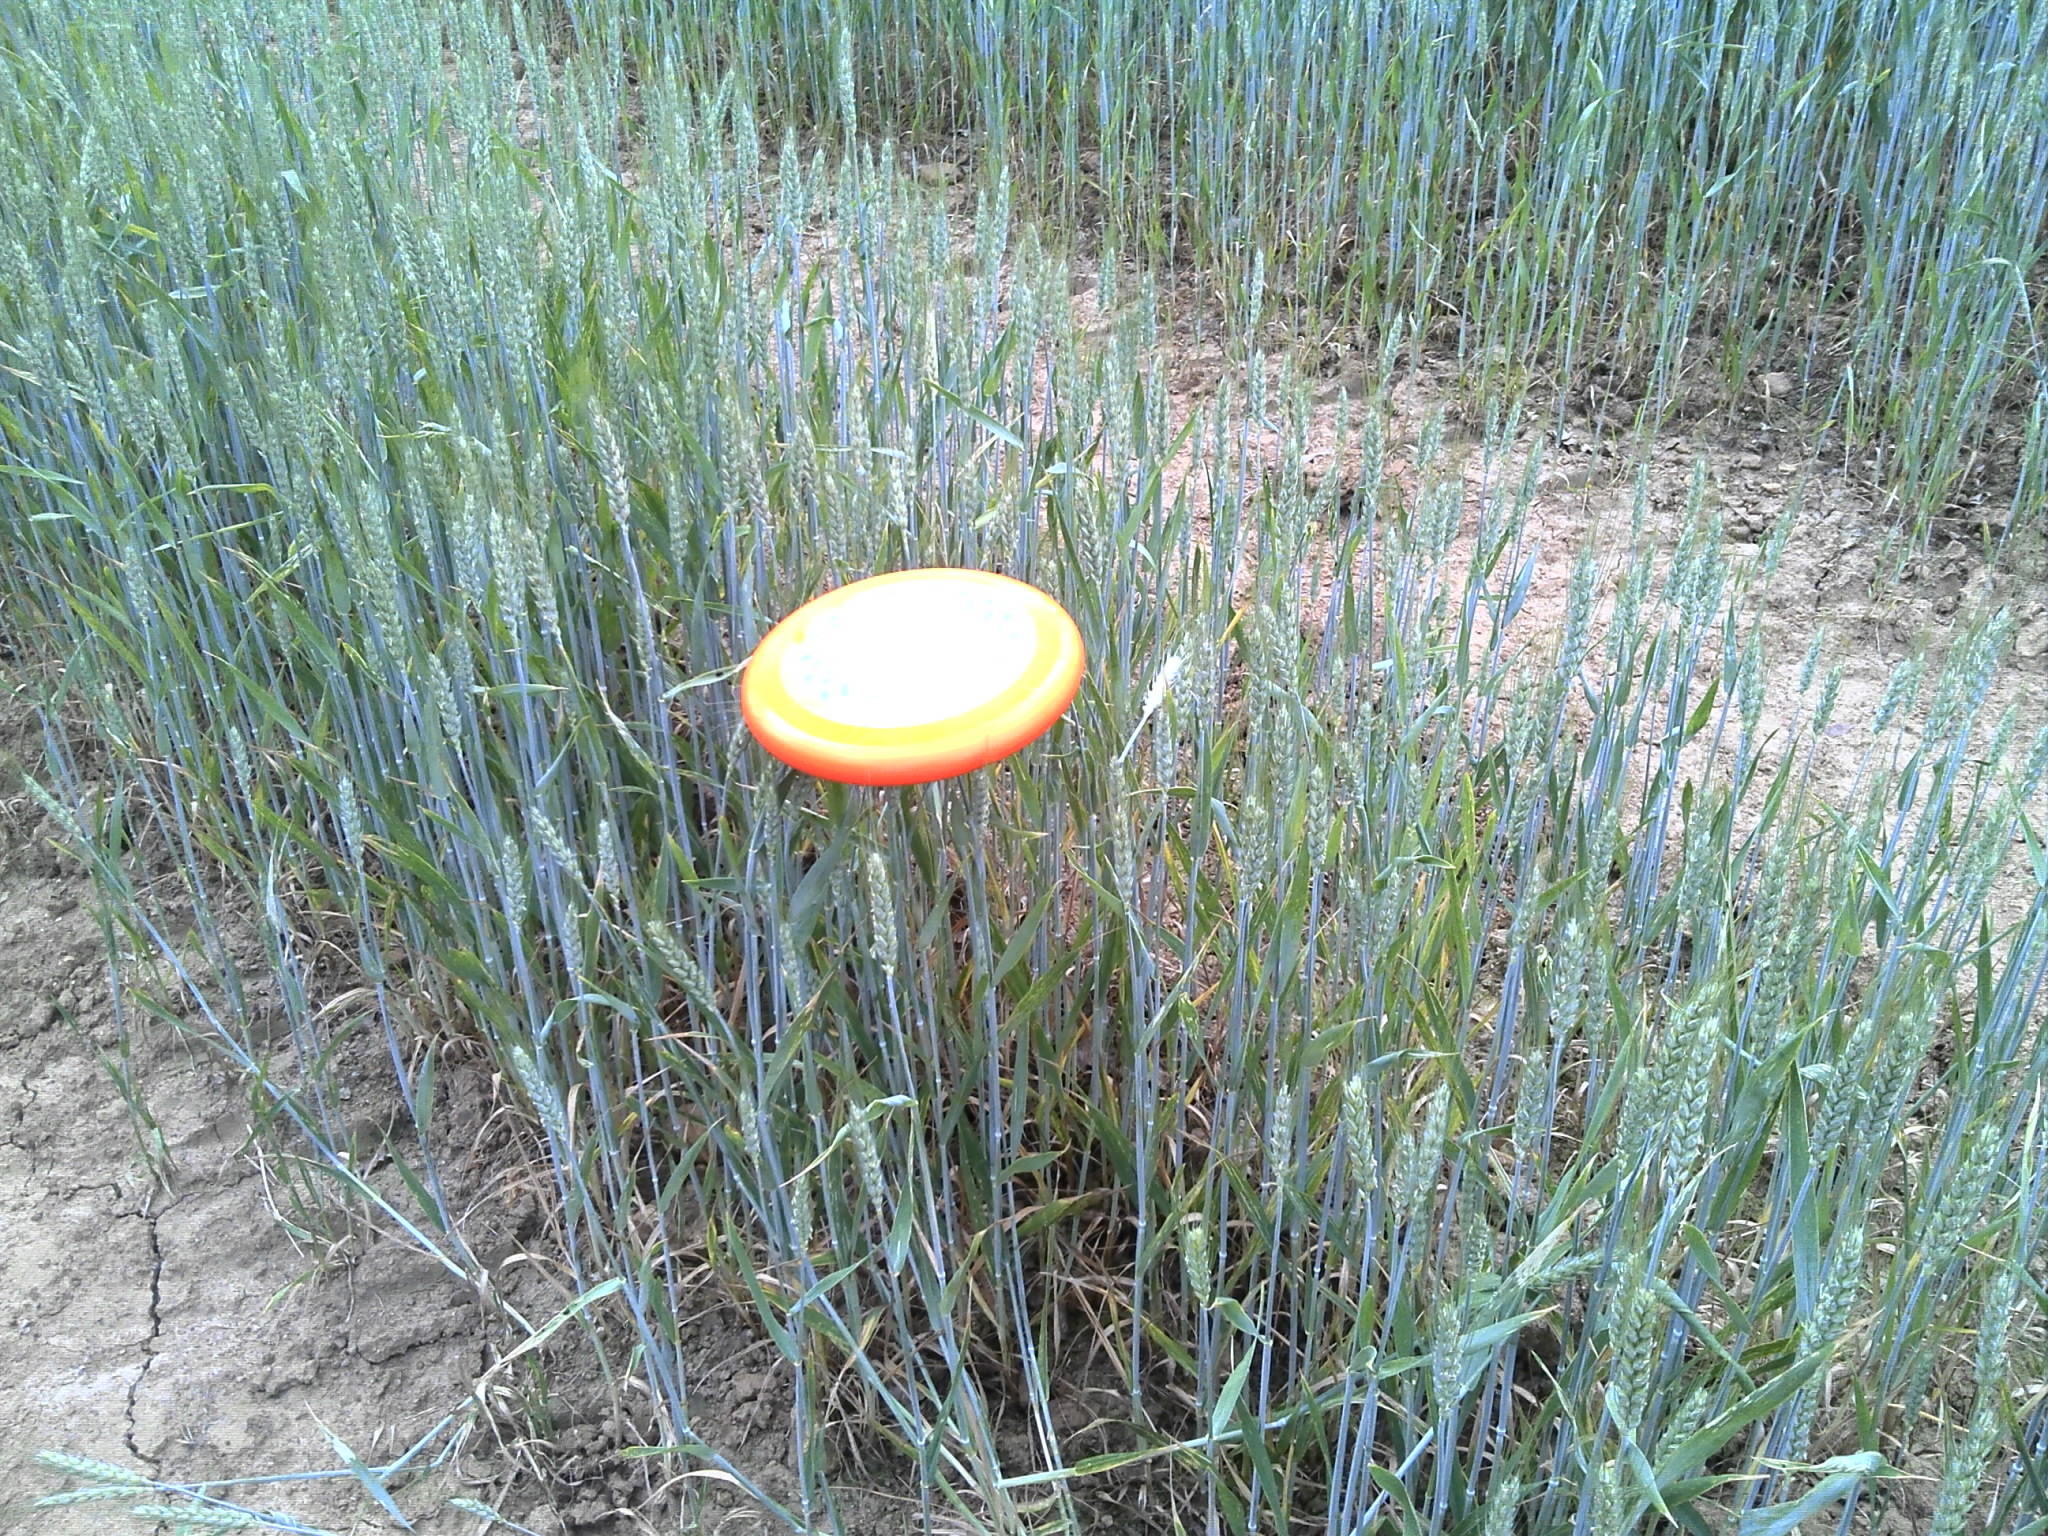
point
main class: Cropland
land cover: Common wheat
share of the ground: > 75 %
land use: Agriculture (excluding fallow land and kitchen gardens)
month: May
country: FR
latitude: 46.5912
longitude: 1.4924
